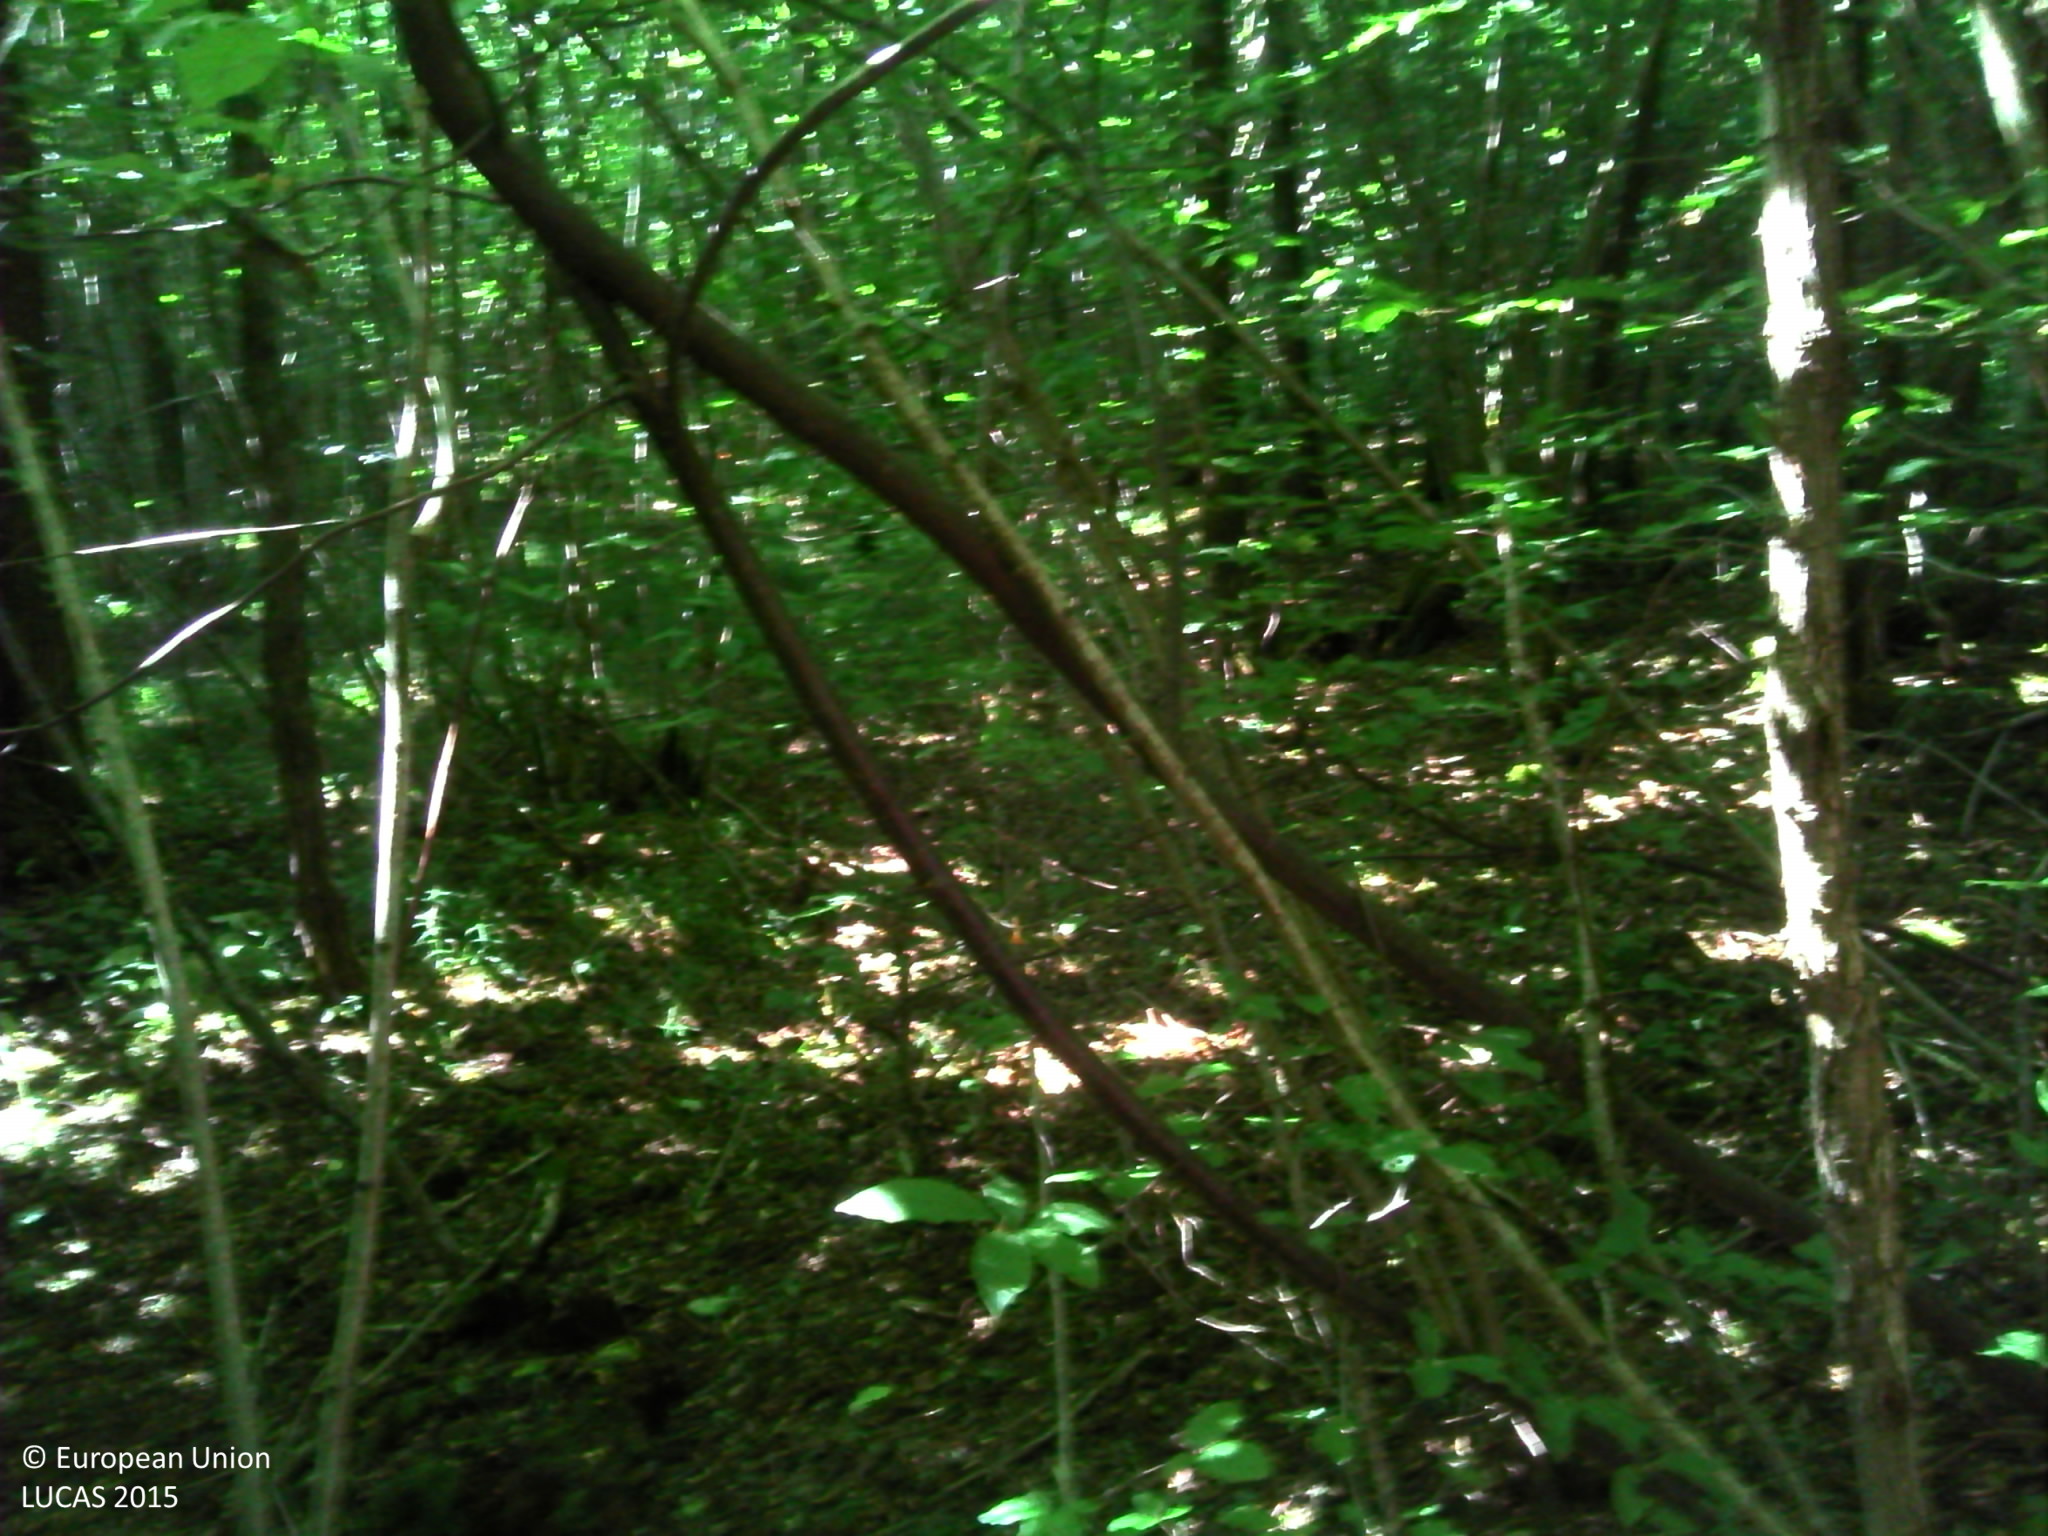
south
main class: Woodland
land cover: Broadleaved woodland
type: mesophytic deciduous forest
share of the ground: > 75 %
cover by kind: broadleaved forest trees 90 %, herbaceous plants 5 %, lichens and mosses 5 %
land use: Forestry
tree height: > 5 m
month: July
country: FR
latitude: 48.4320
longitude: 6.3106
